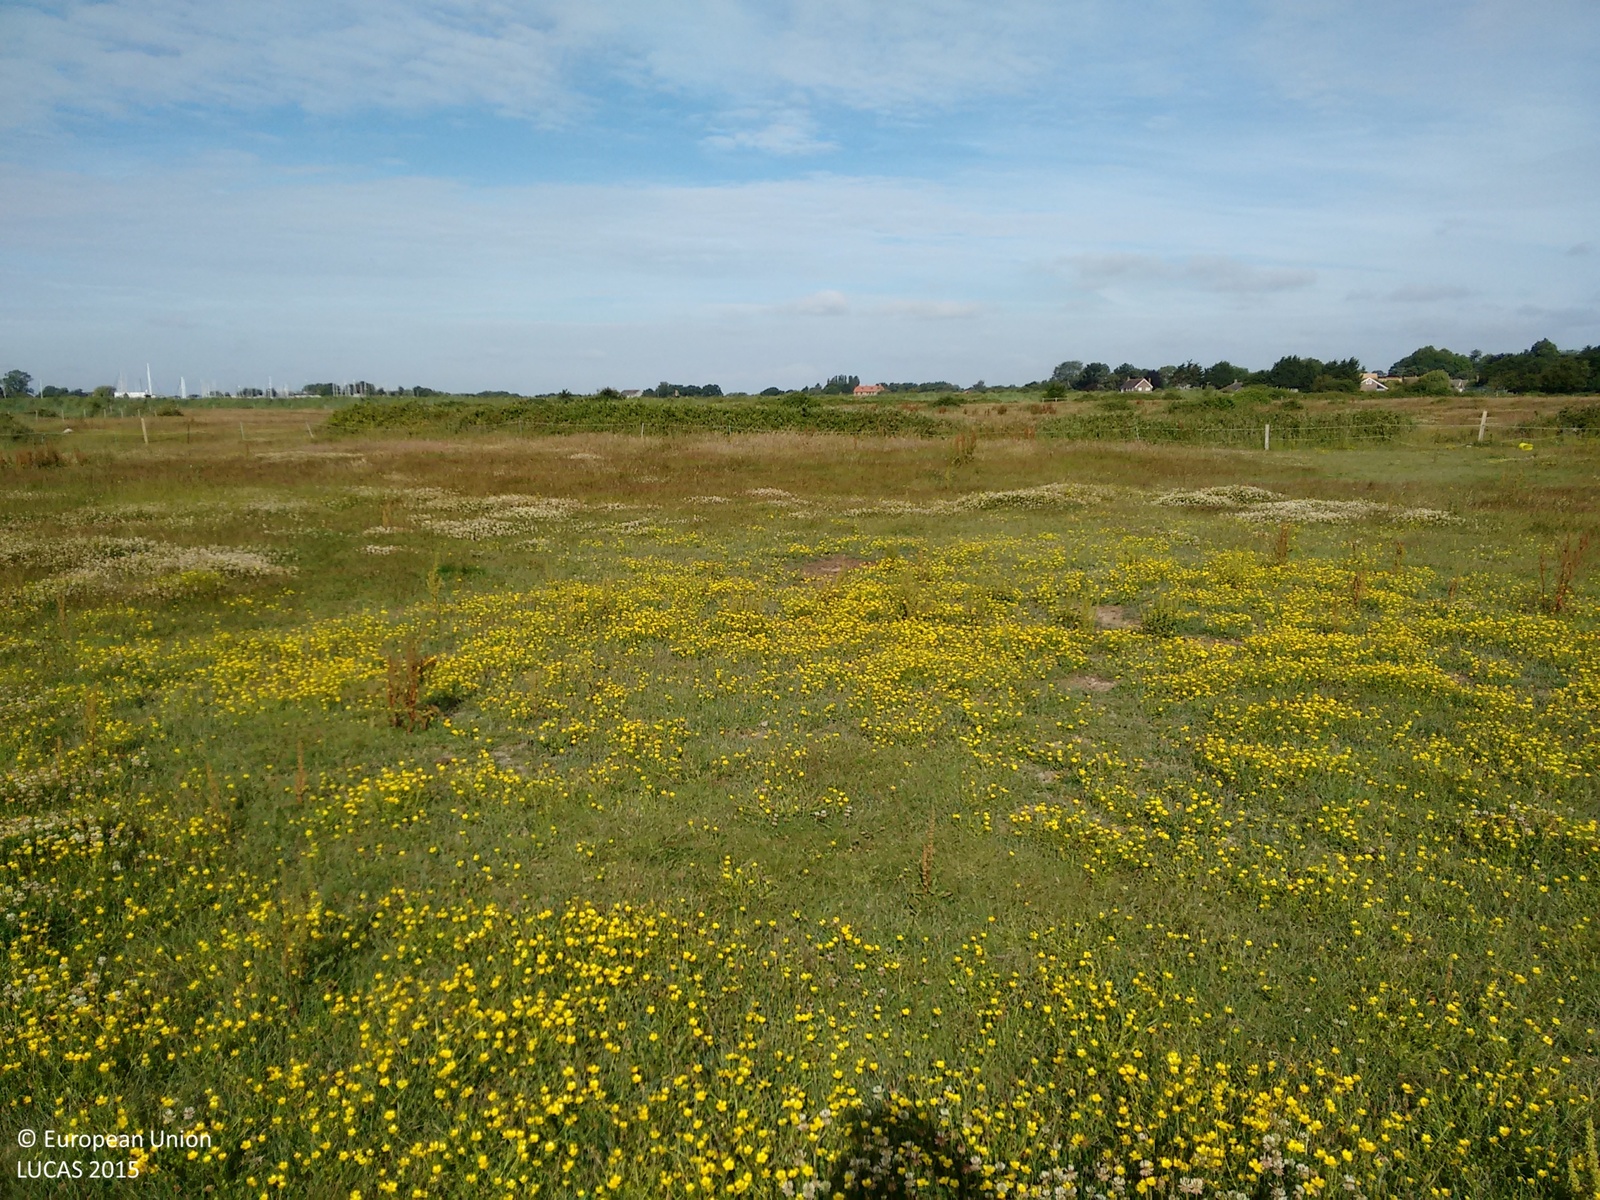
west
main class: Grassland
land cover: Grassland without tree/shrub cover
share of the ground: > 75 %
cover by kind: herbaceous plants 100 %
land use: Agriculture (excluding fallow land and kitchen gardens)
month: June
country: GB
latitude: 50.8389
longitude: -0.9065
